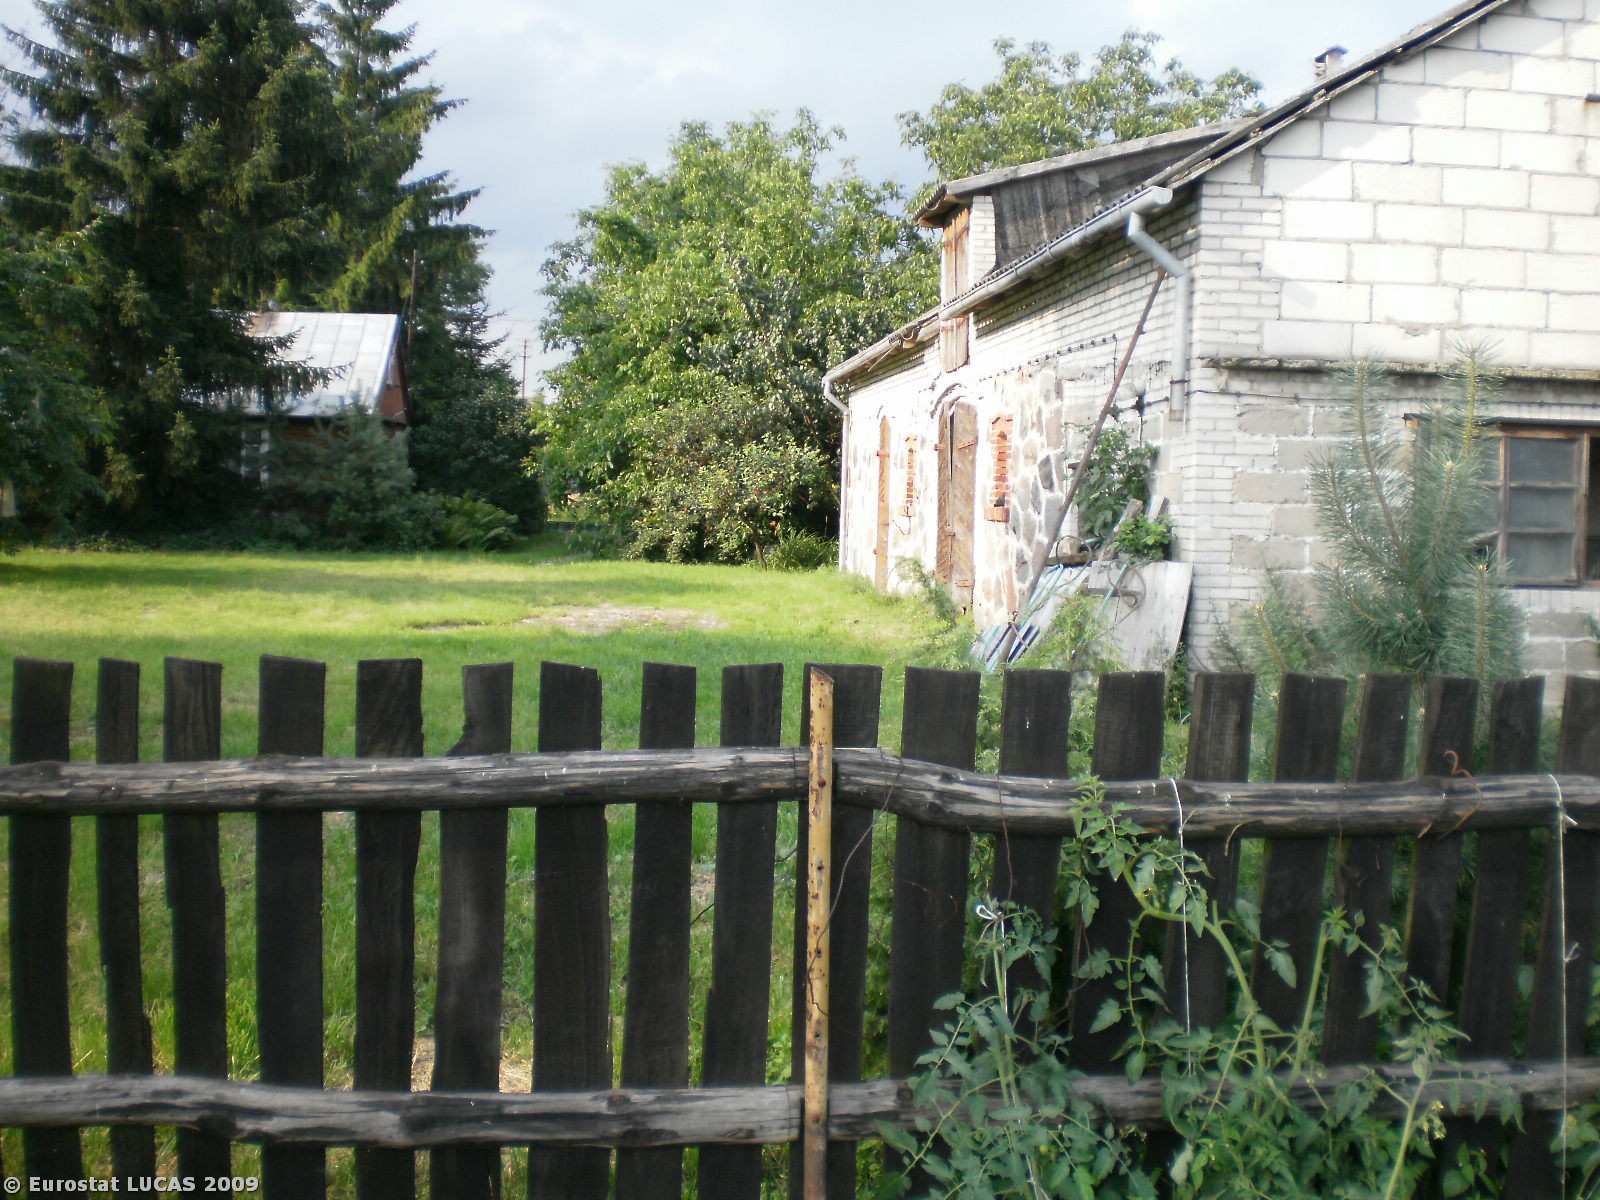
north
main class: Grassland
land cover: Grassland without tree/shrub cover
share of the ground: > 75 %
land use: Road transport
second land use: Agriculture (excluding fallow land and kitchen gardens)
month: July
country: PL
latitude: 52.8035
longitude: 20.8556
